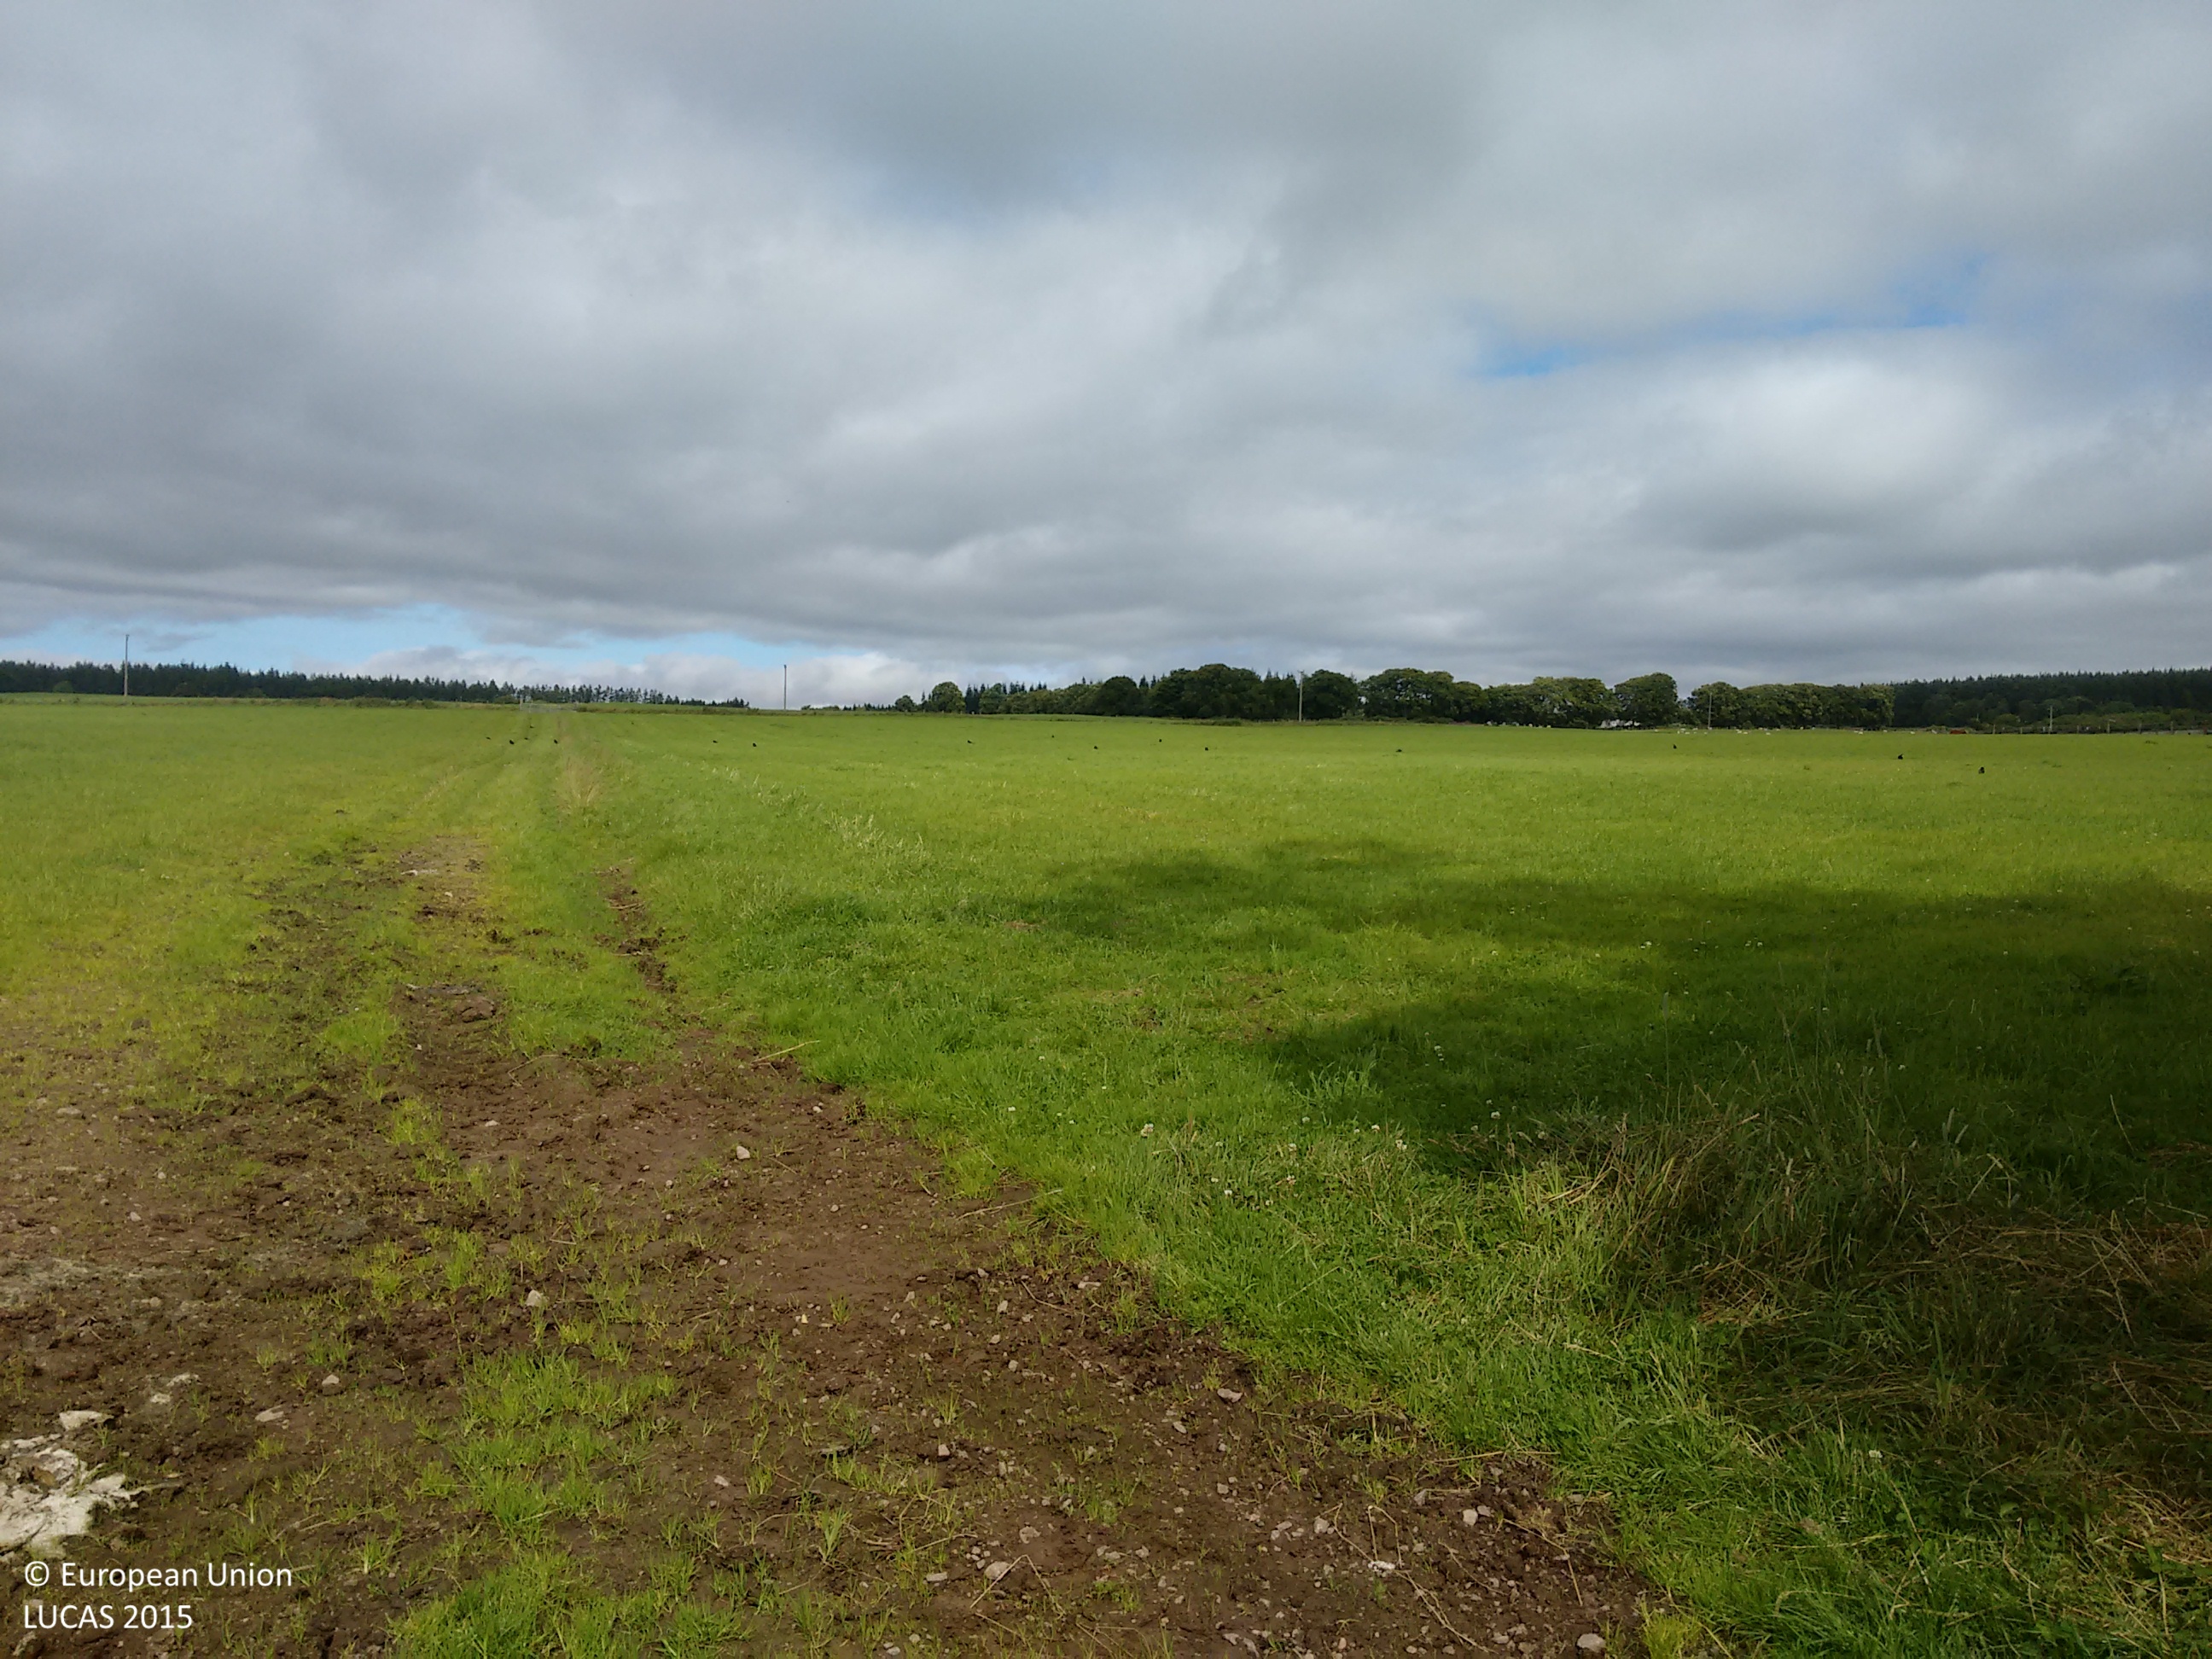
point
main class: Grassland
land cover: Grassland without tree/shrub cover
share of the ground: > 75 %
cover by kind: herbaceous plants 100 %
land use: Agriculture (excluding fallow land and kitchen gardens)
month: August
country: GB
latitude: 57.5332
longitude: -4.3685
